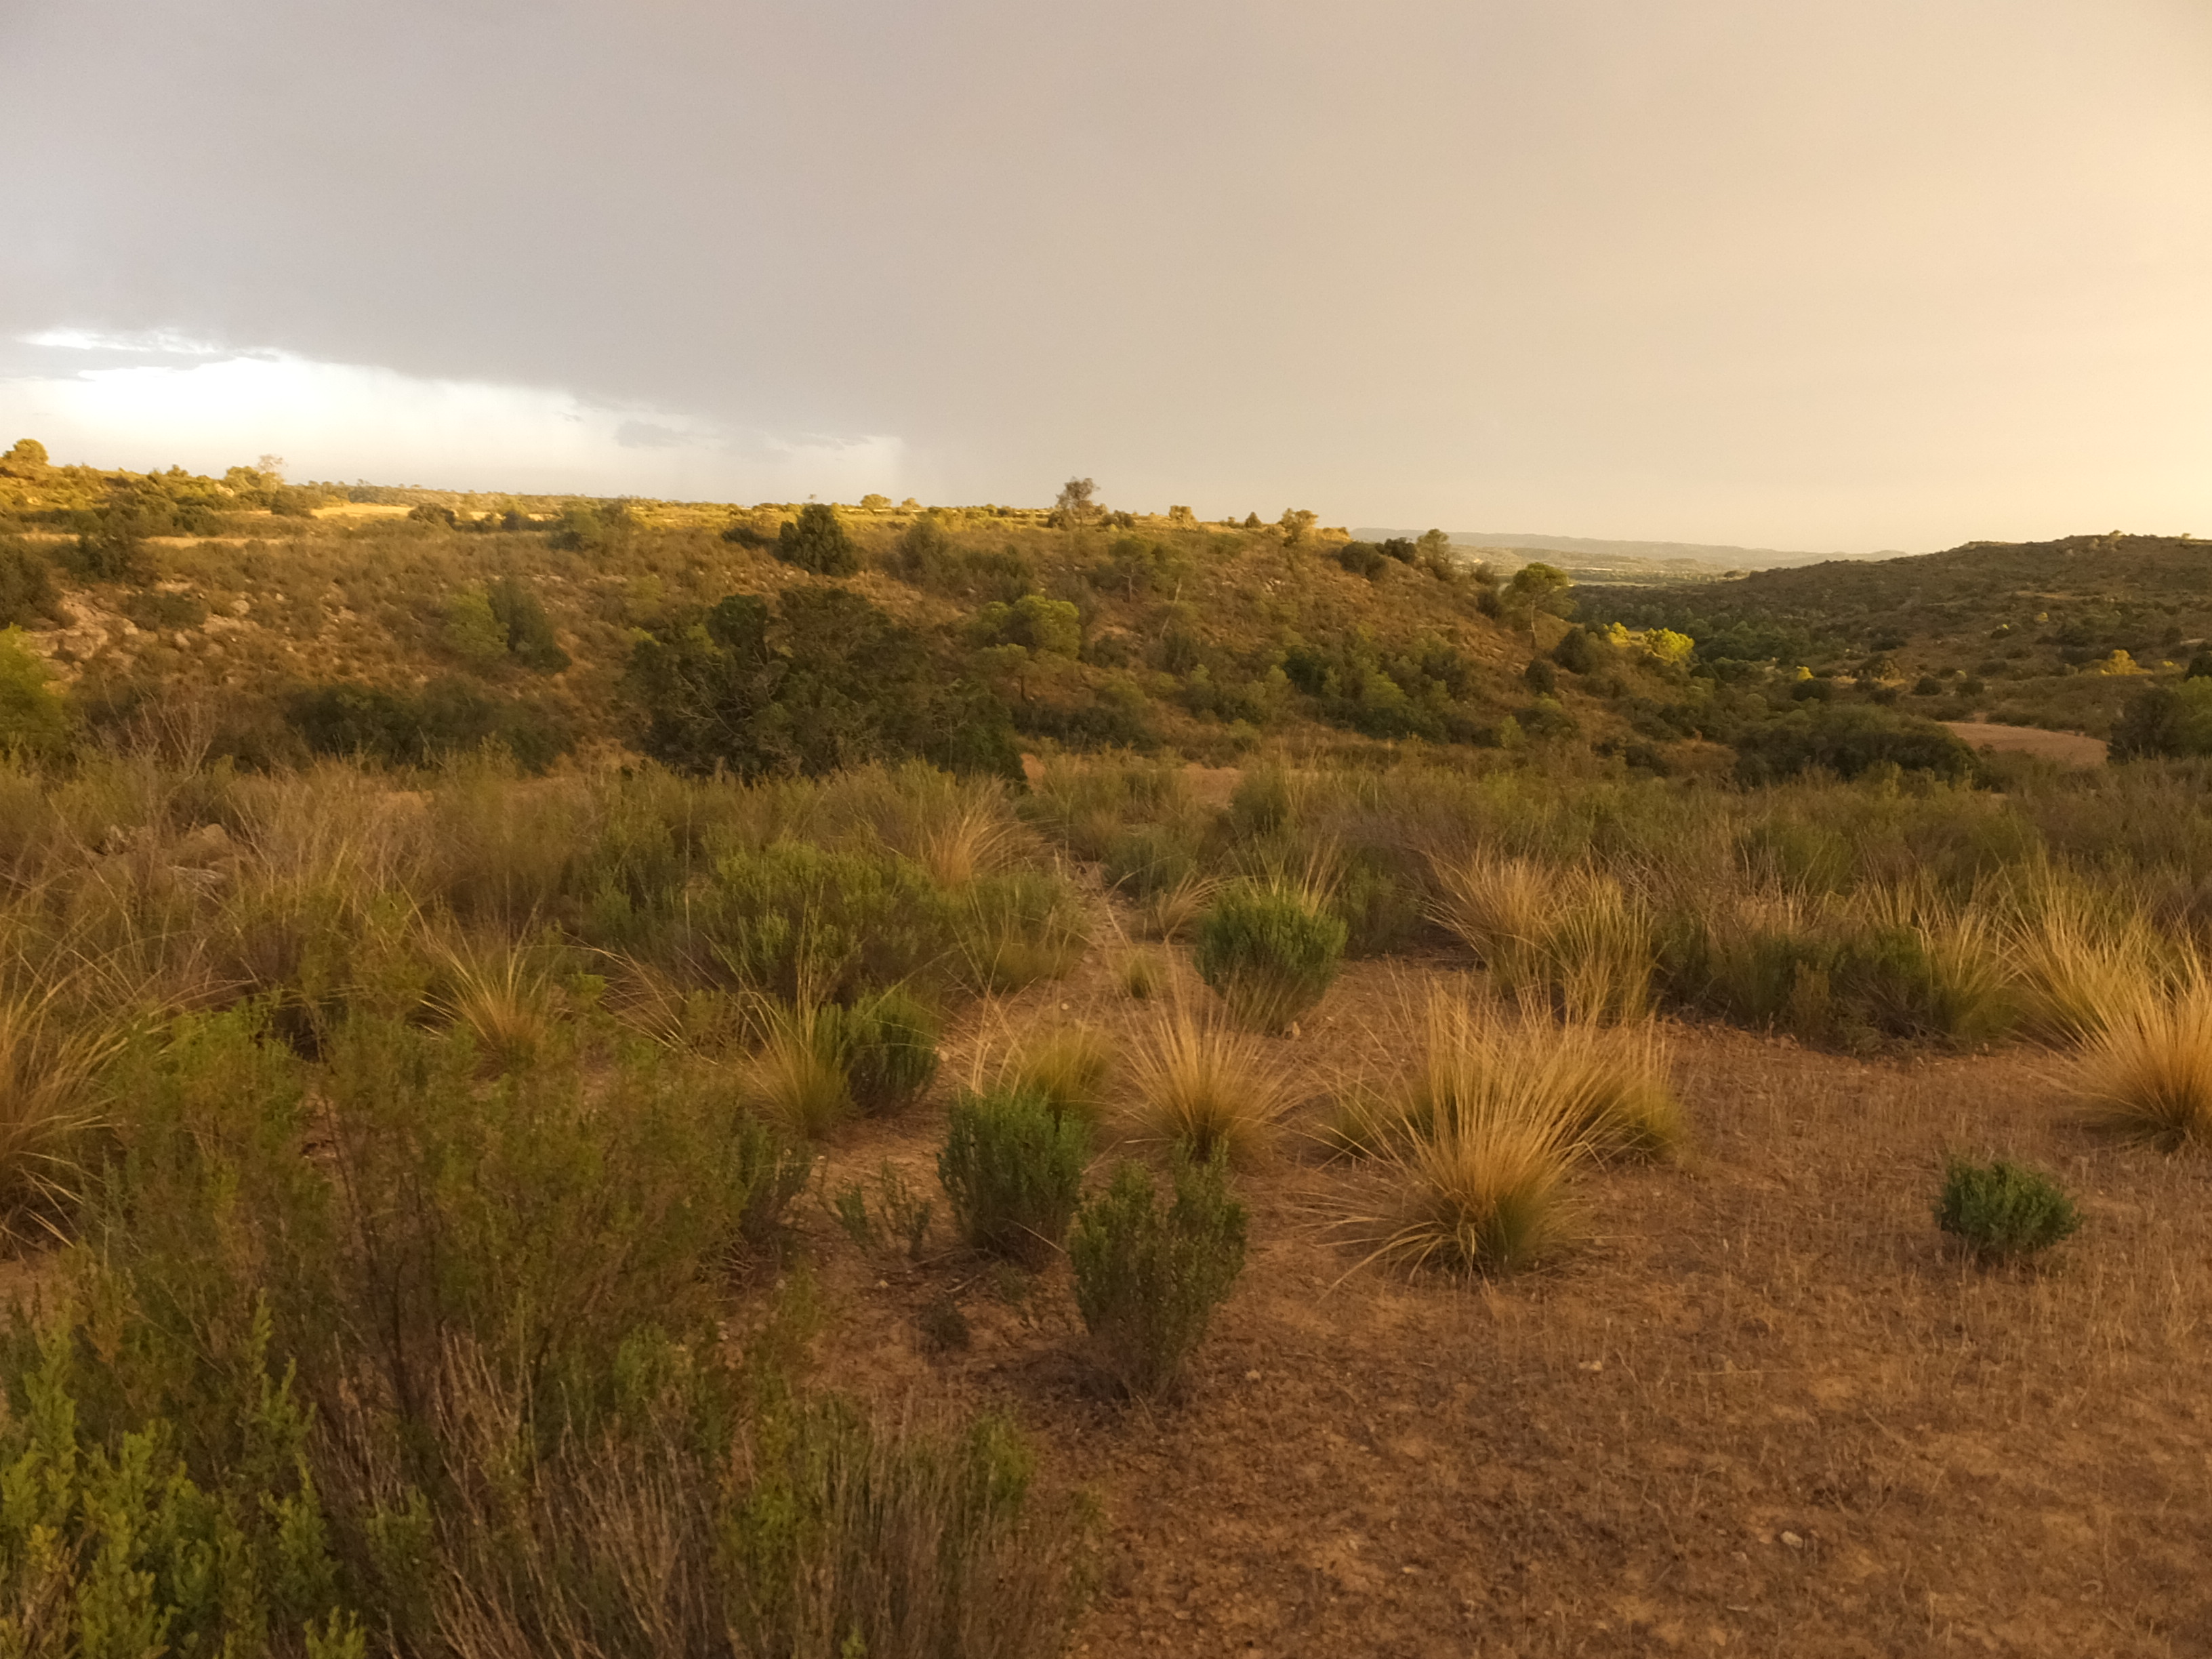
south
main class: Shrubland
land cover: Shrubland with sparse tree cover
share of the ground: > 75 %
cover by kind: shrubs 70 %, herbaceous plants 20 %, coniferous forest trees 5 %, consolidated bare surface 5 %
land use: Semi-natural and natural areas not in use
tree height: < 5 m
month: August
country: ES
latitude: 41.3473
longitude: 0.0794
